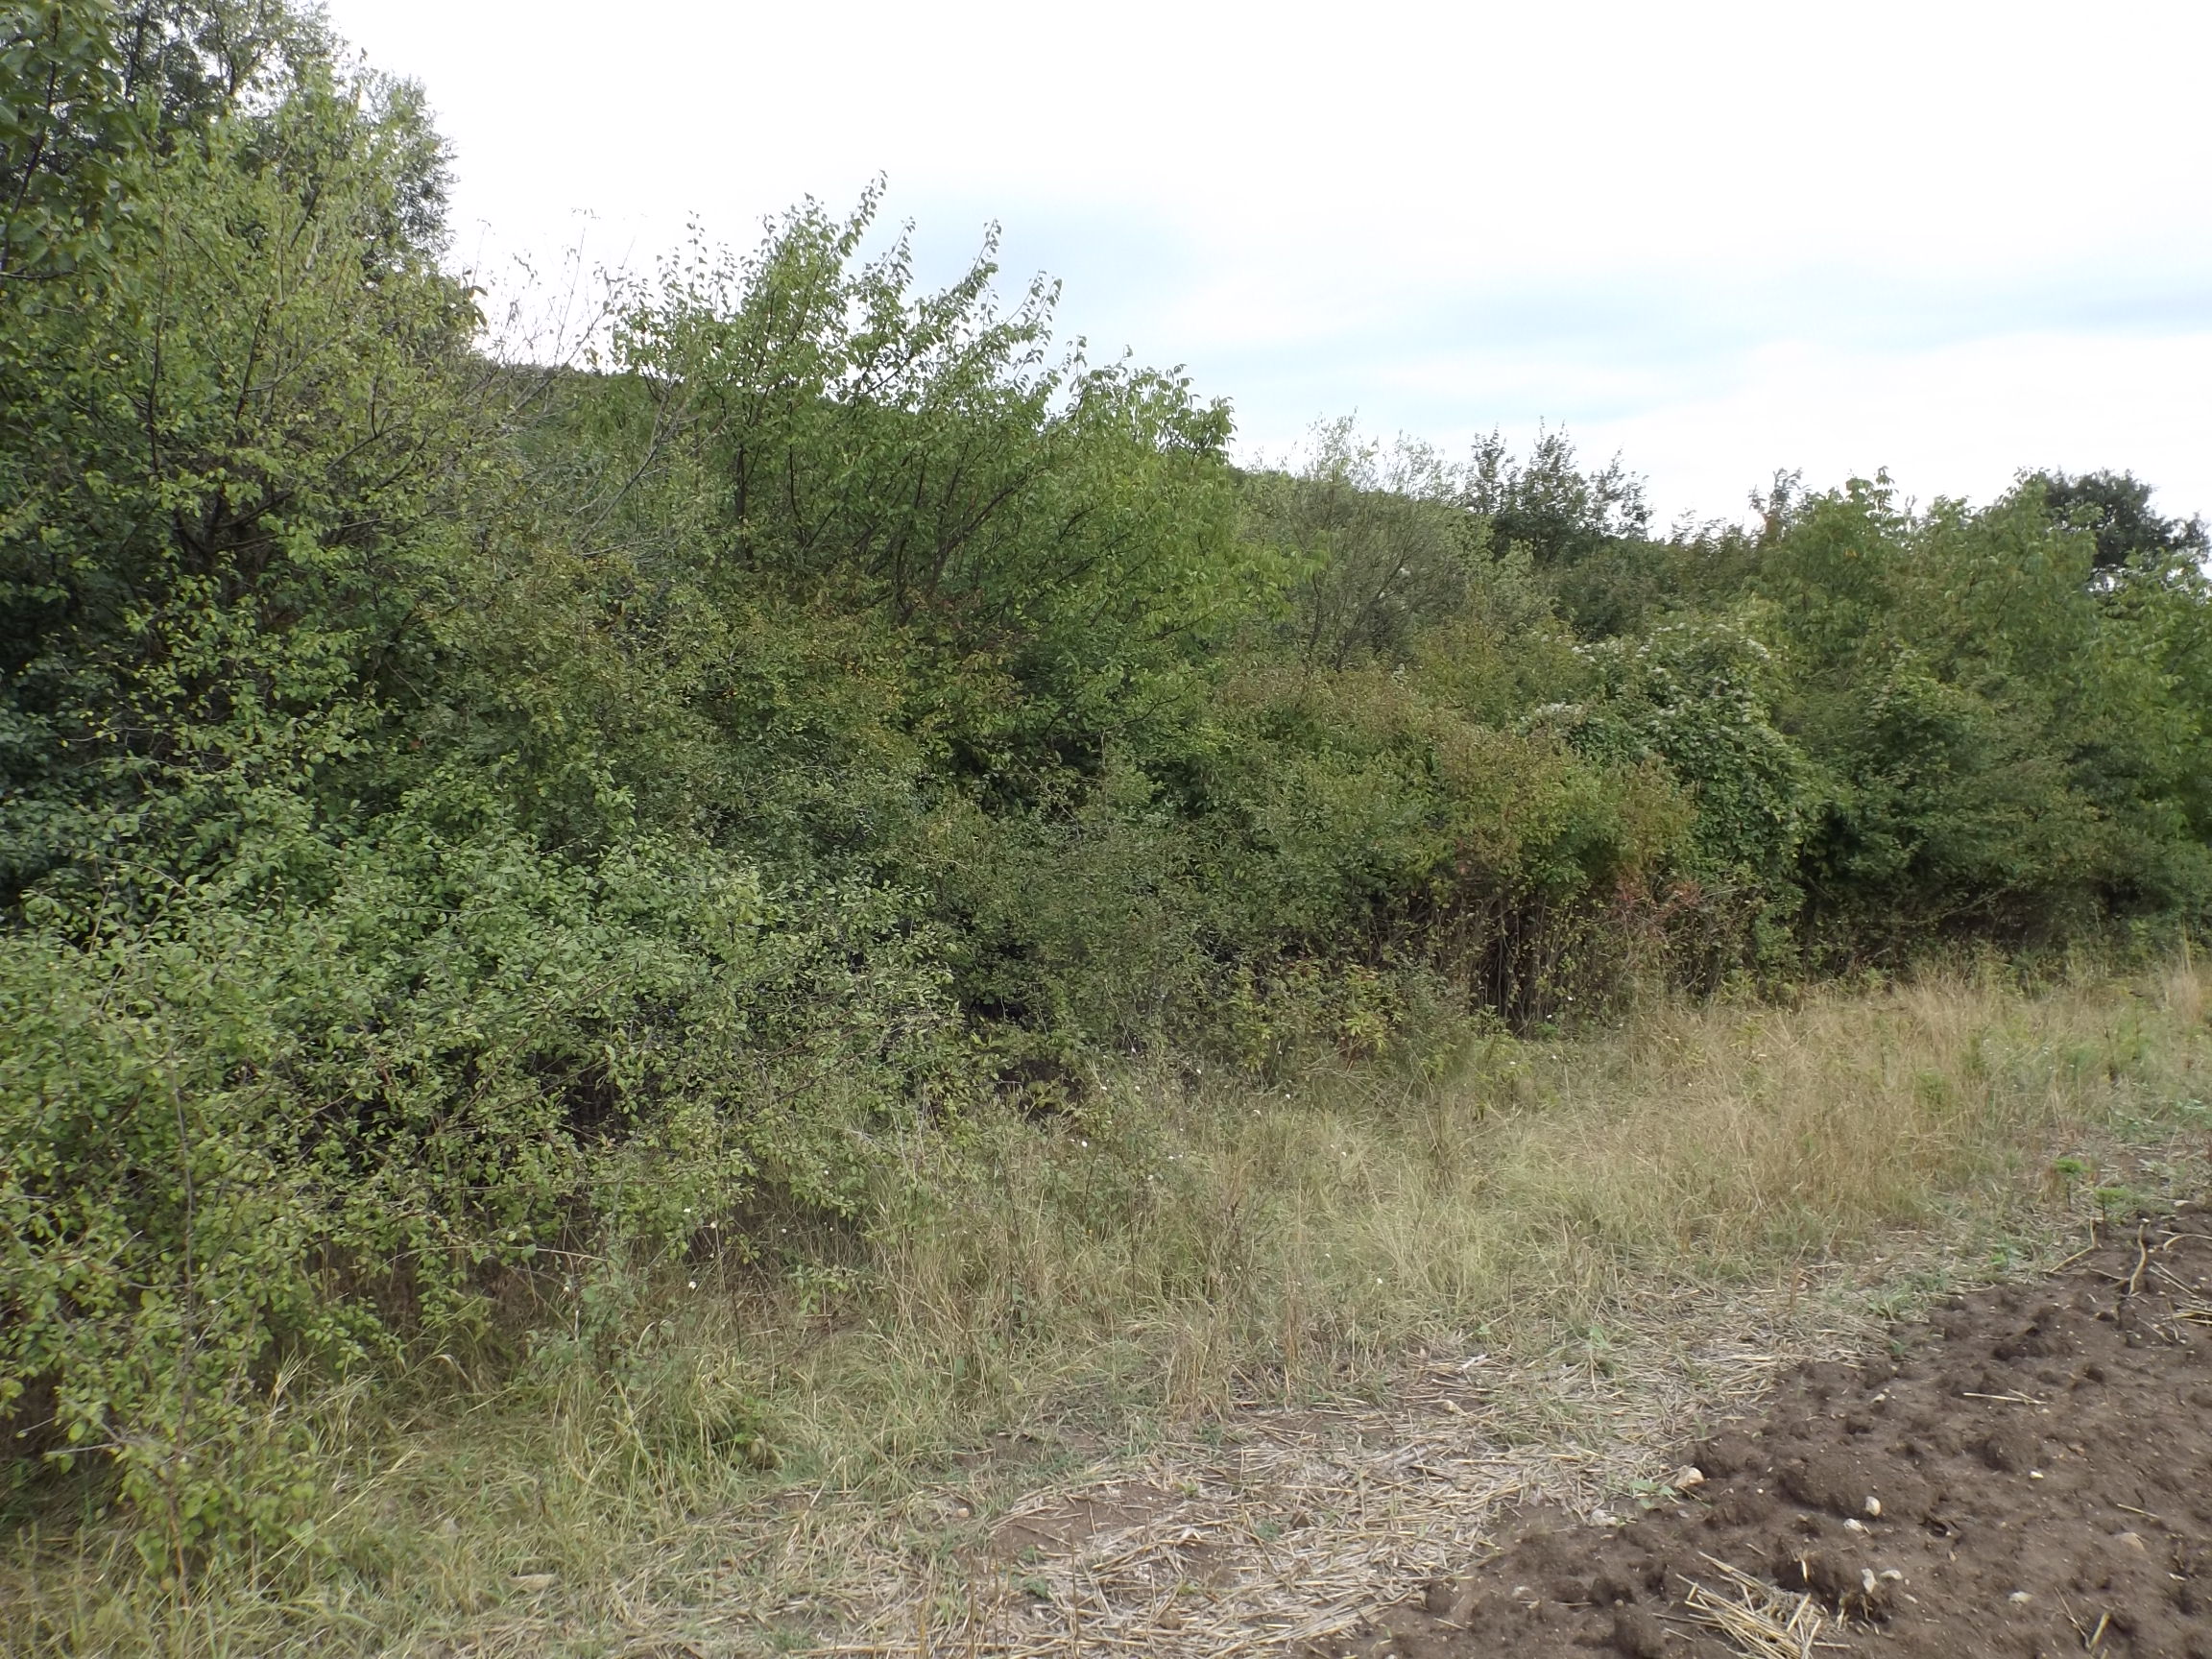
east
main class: Cropland
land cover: Common wheat
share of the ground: < 10 %
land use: Agriculture (excluding fallow land and kitchen gardens)
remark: Harvested field
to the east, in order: Common wheat; Broadleaved woodland; Rivers and streams; Broadleaved woodland
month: August
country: BG
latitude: 43.3497
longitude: 27.5884
